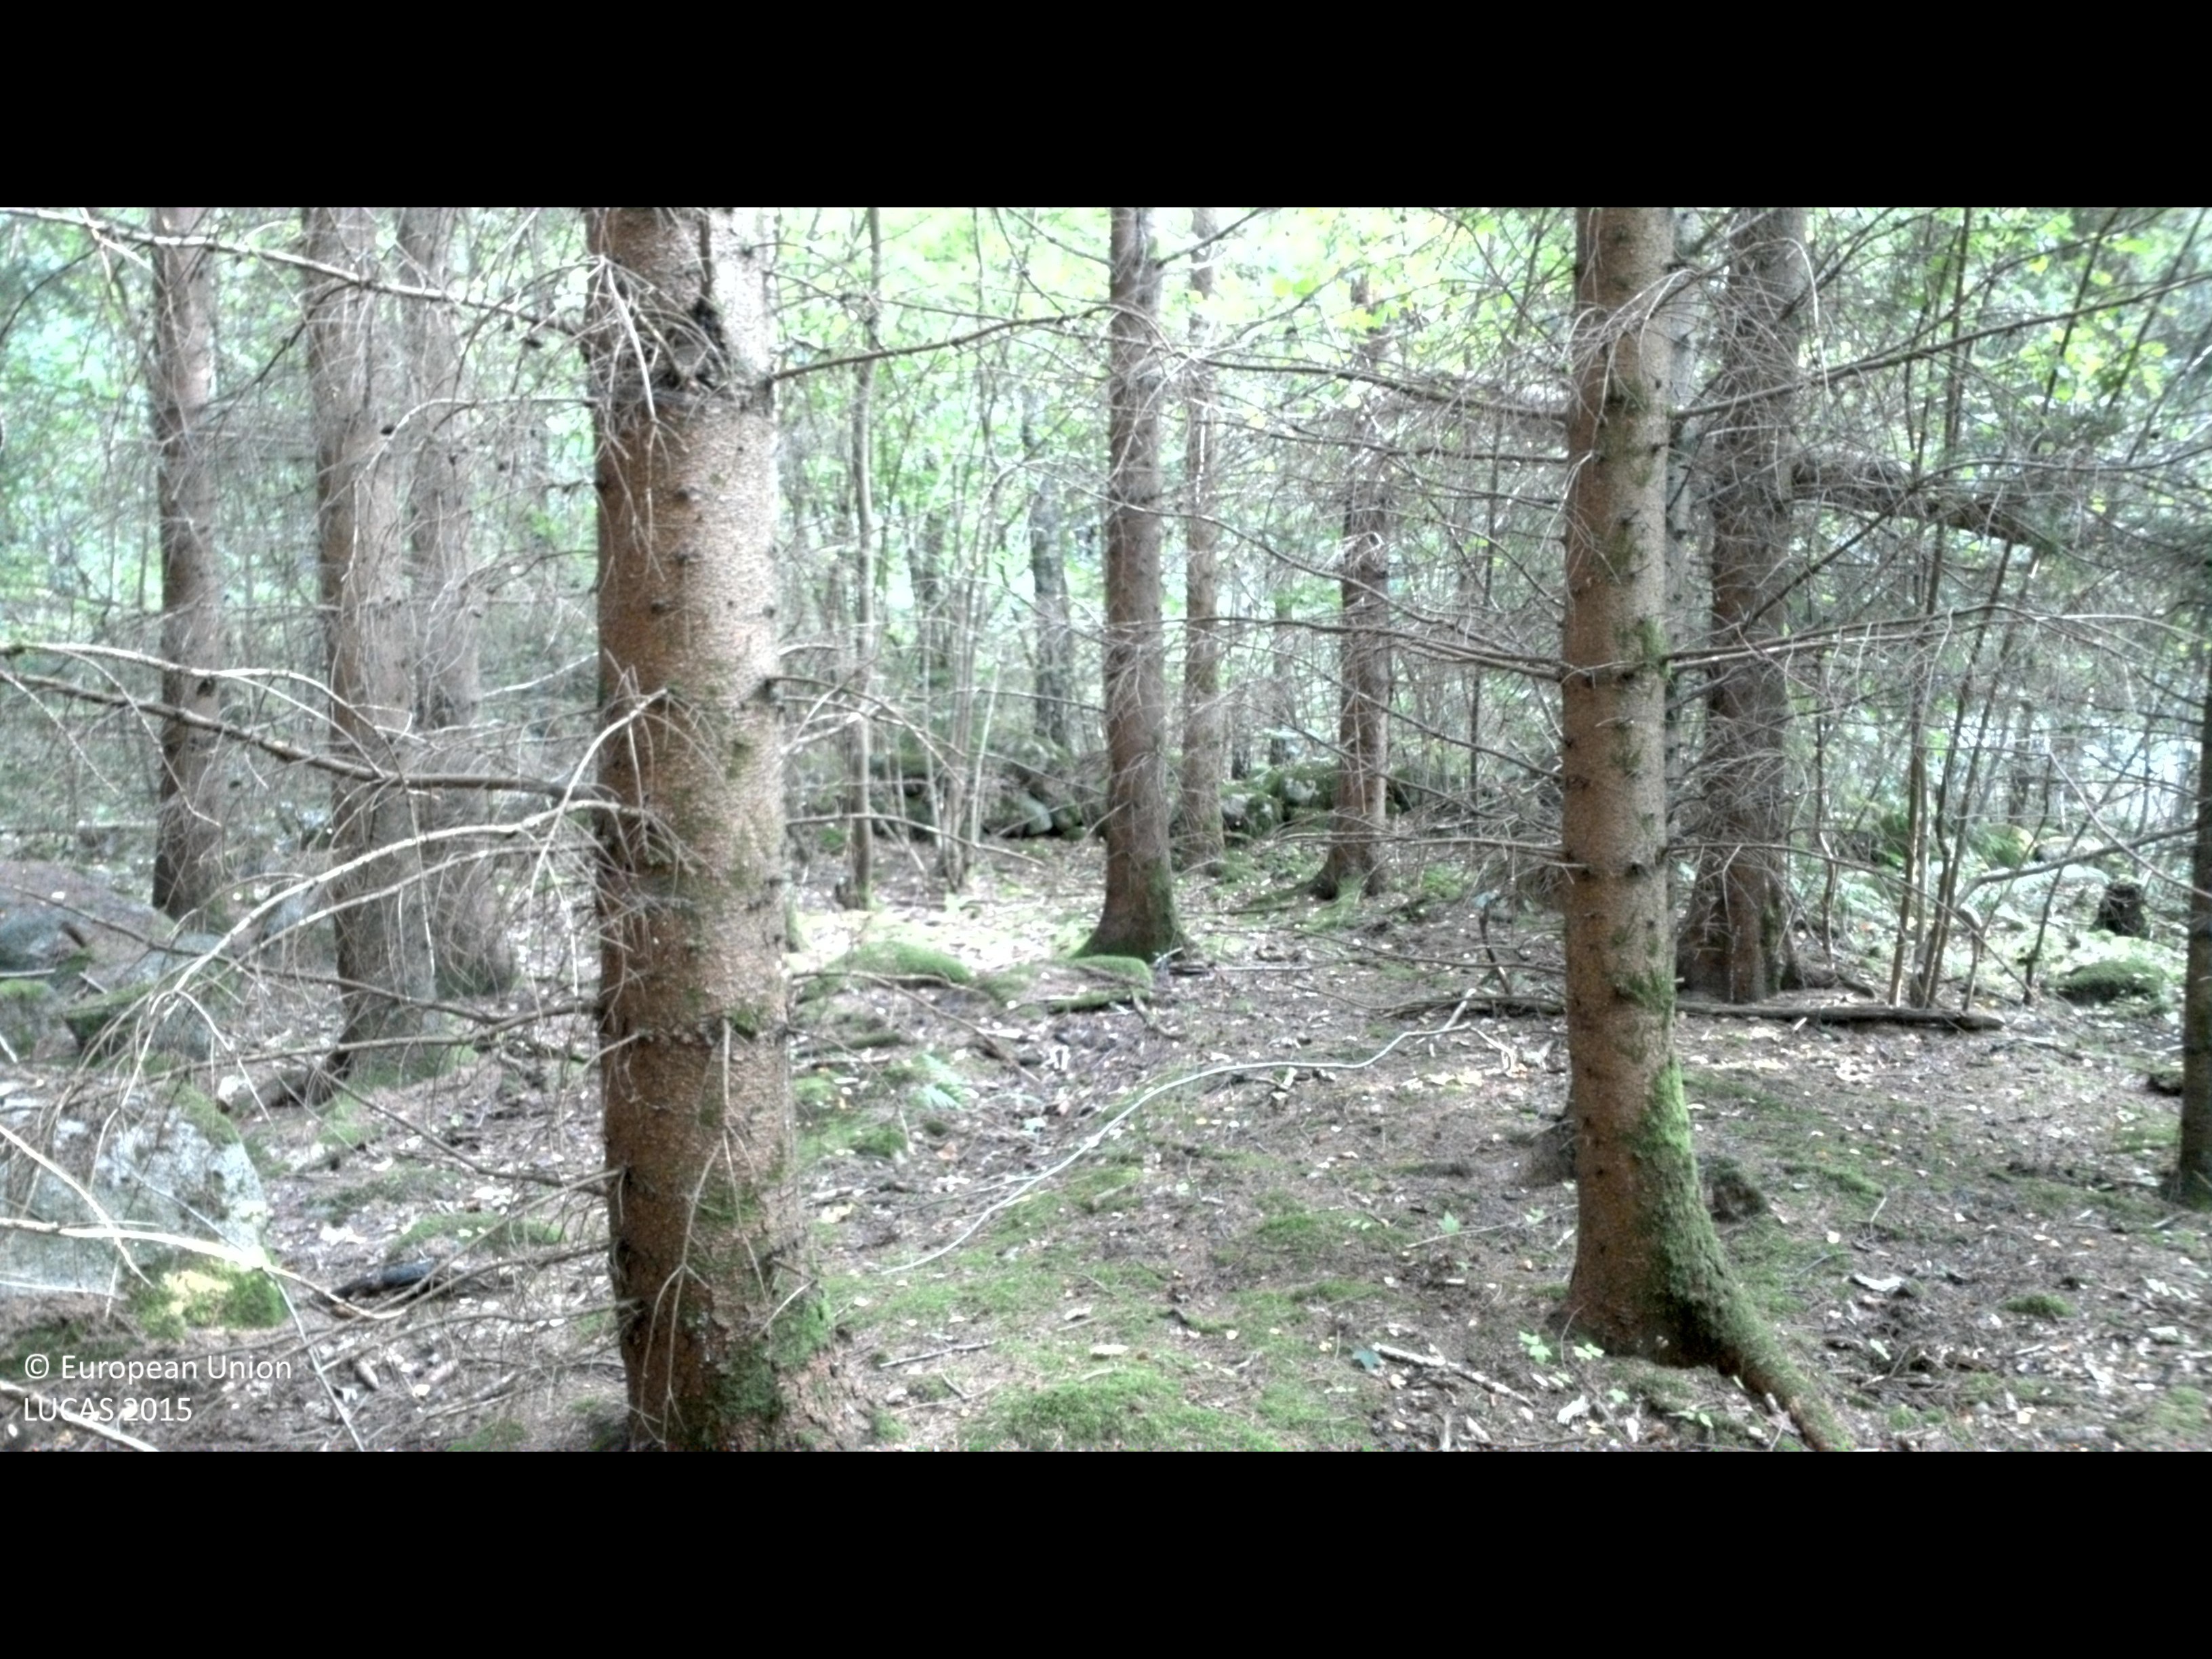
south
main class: Woodland
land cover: Spruce dominated coniferous woodland
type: boreal forest
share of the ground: > 75 %
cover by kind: coniferous forest trees 90 %, lichens and mosses 5 %, unconsolidated bare surface 5 %
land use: Forestry
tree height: > 5 m
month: September
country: SE
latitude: 56.1351
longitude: 14.2620
